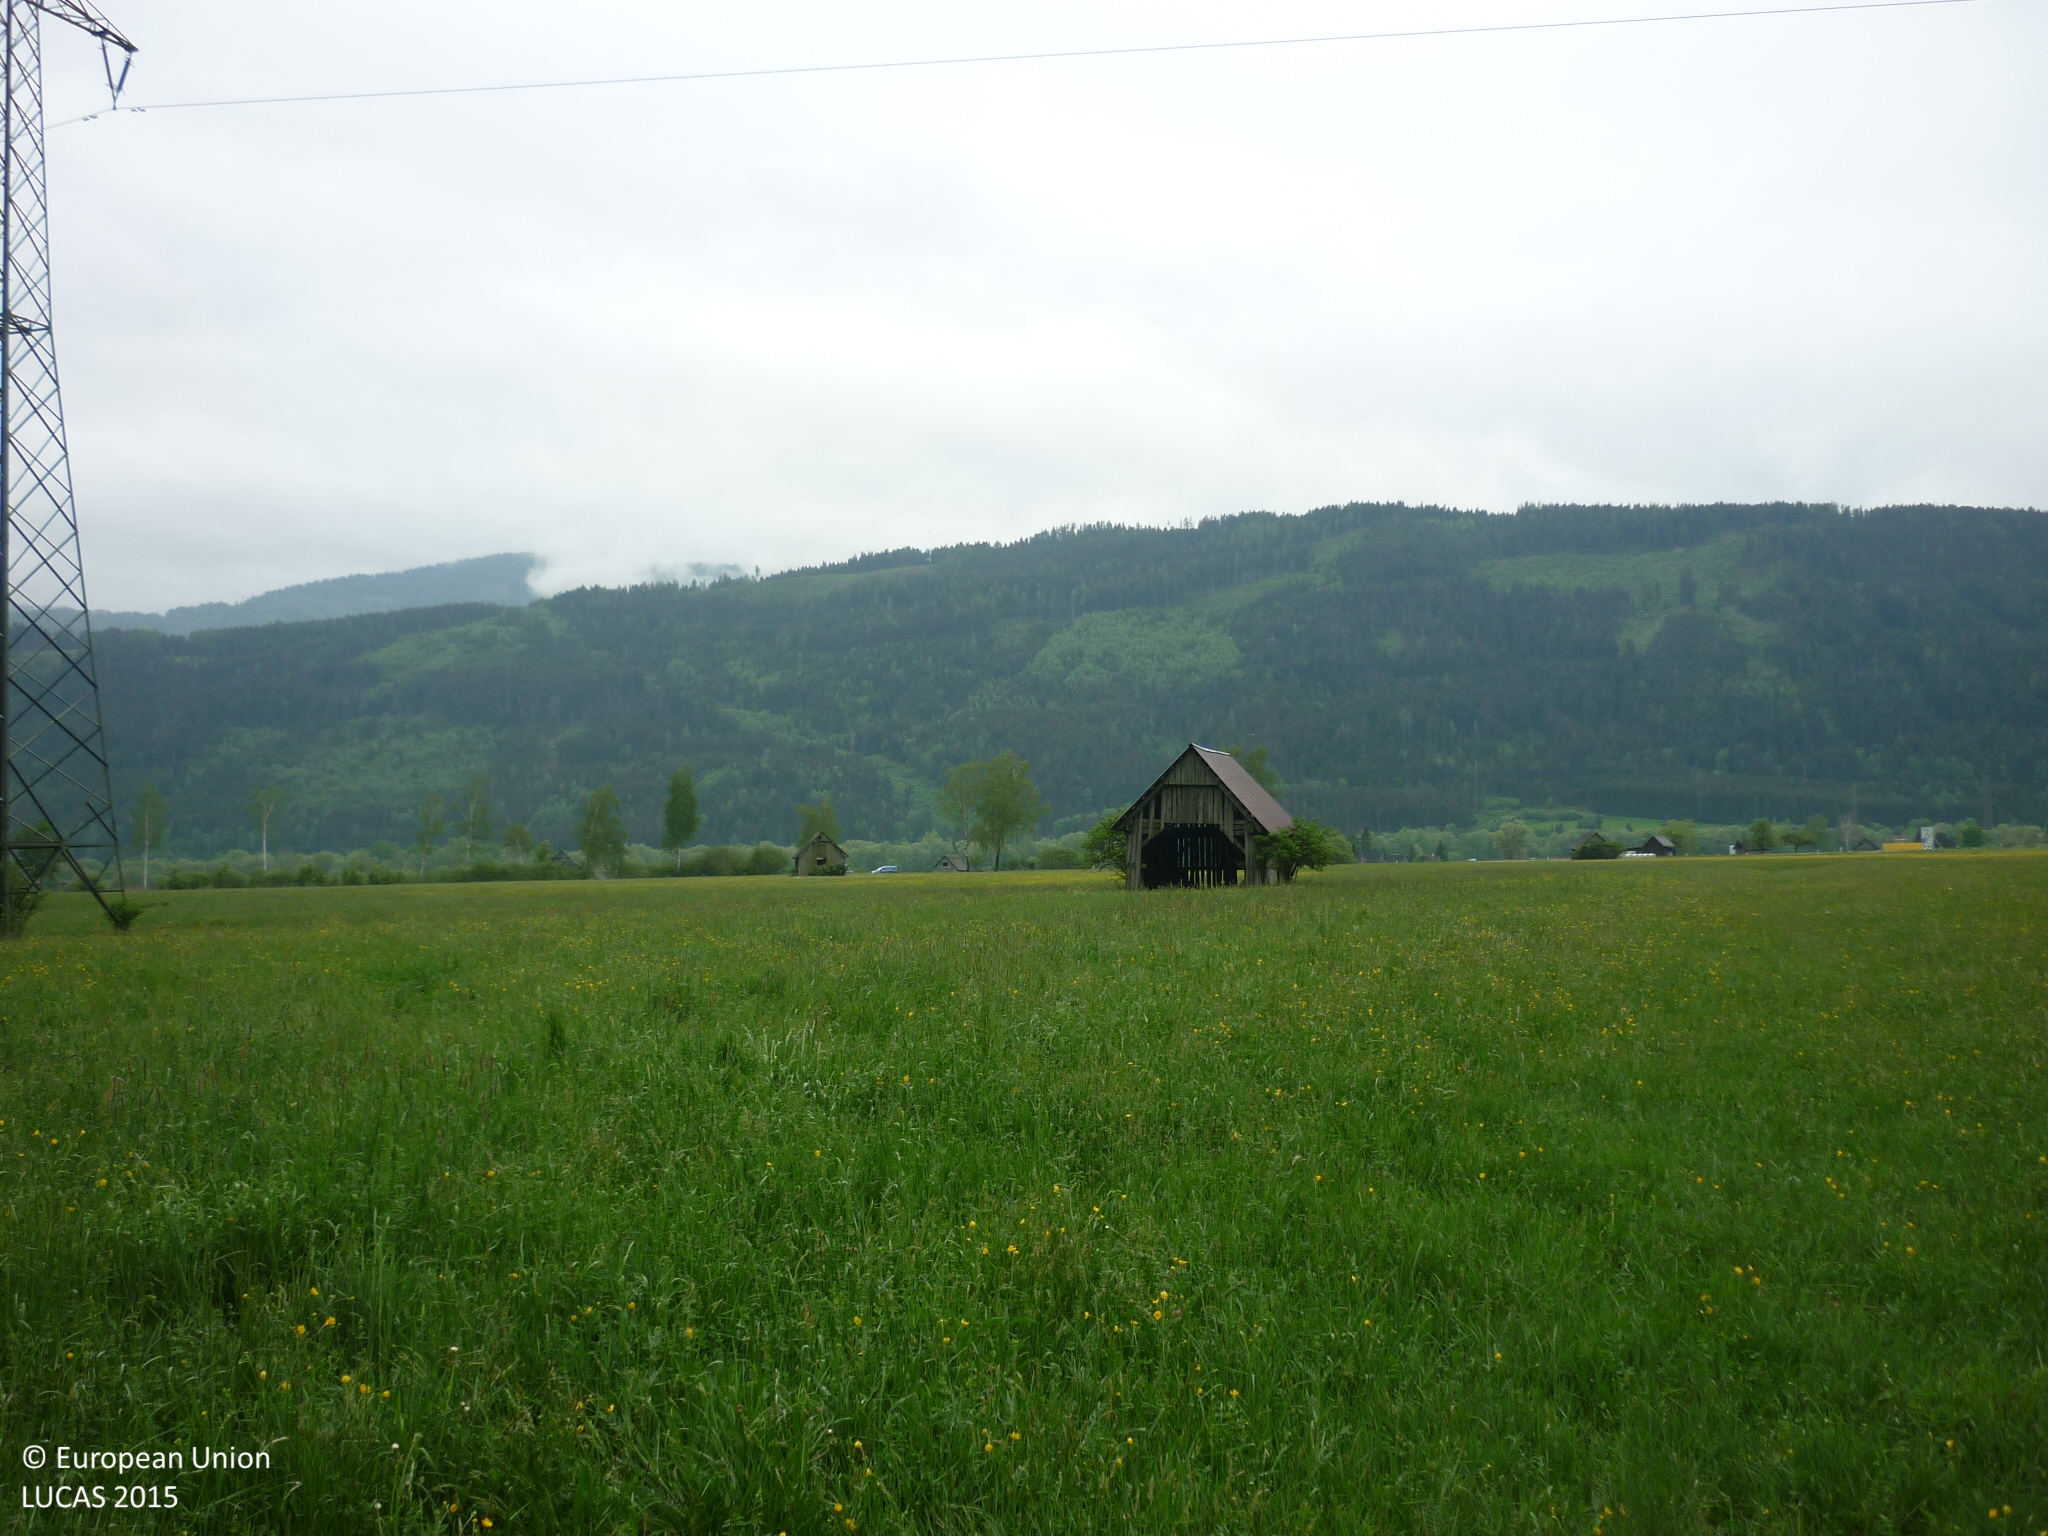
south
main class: Grassland
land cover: Grassland without tree/shrub cover
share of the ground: > 75 %
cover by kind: herbaceous plants 100 %
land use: Agriculture (excluding fallow land and kitchen gardens)
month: May
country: AT
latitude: 47.5643
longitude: 14.2656
